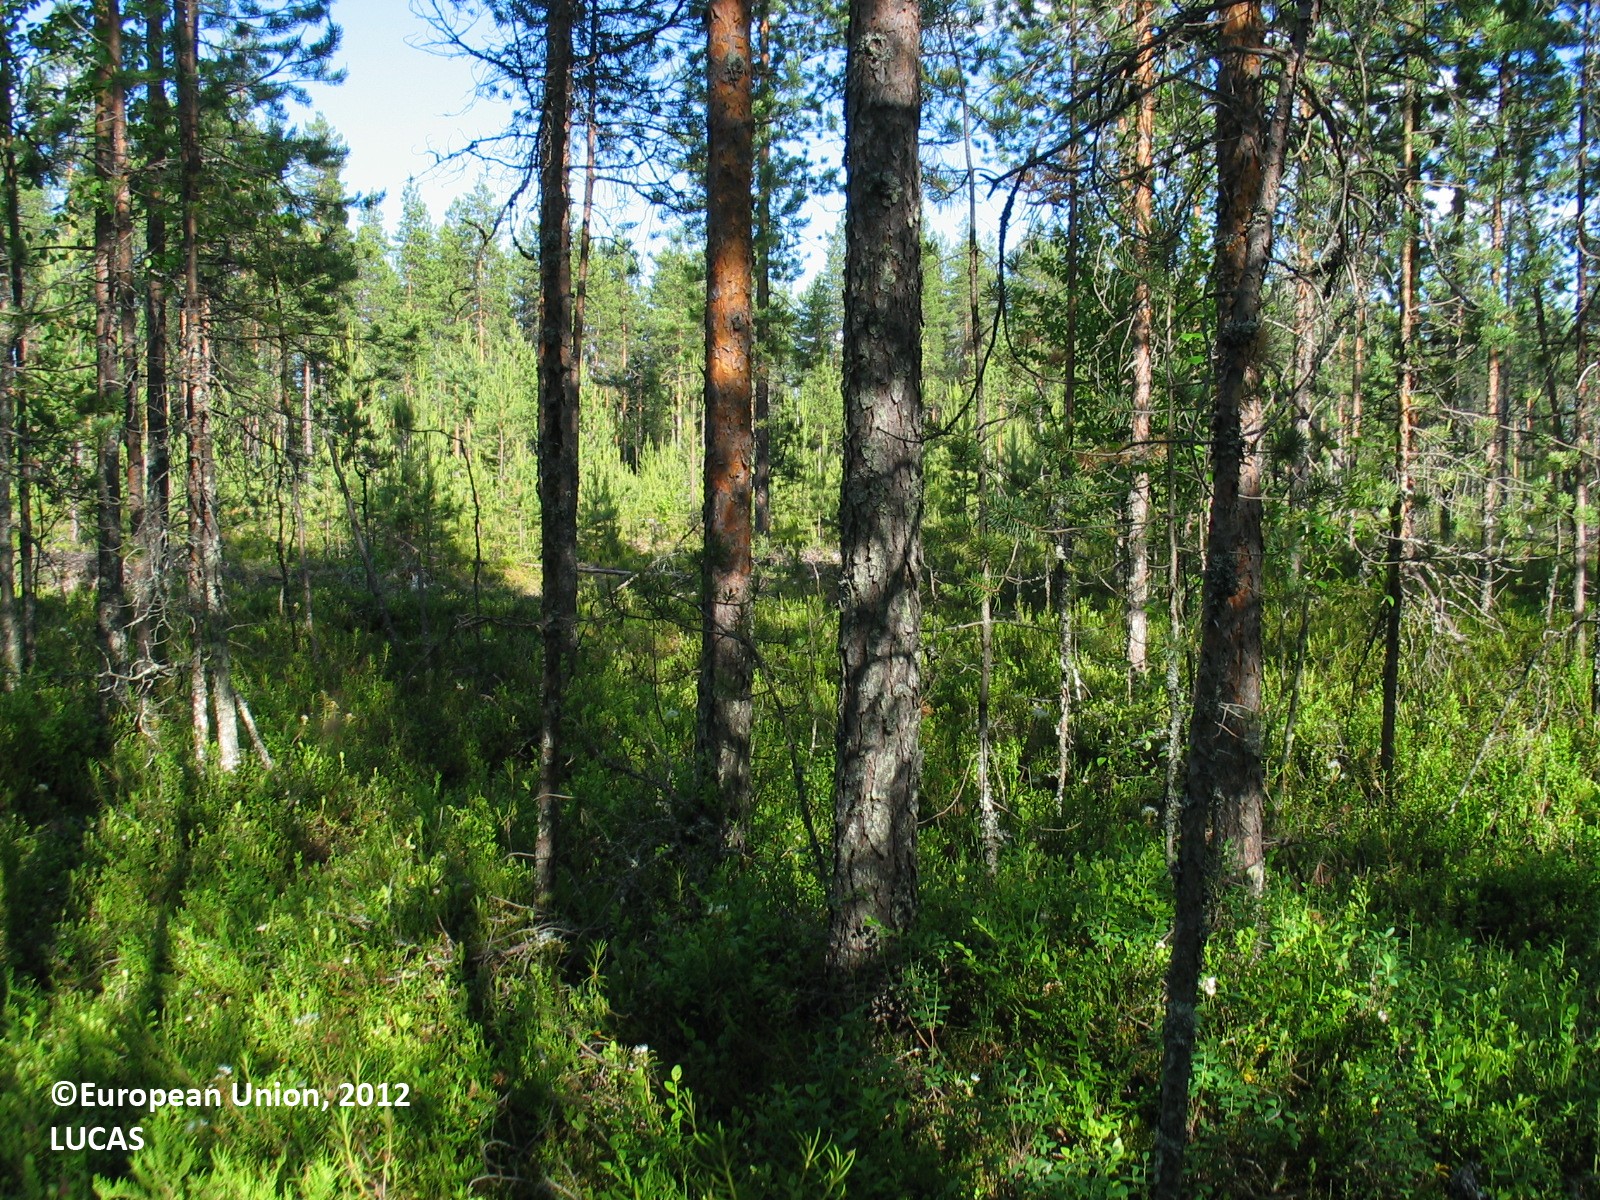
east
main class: Woodland
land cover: Pine dominated coniferous woodland
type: boreal forest
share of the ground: 50 - 75 %
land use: Forestry
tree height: > 5 m
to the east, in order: Pine dominated coniferous woodland; Tracks; Pine dominated coniferous woodland; Ditches and canals; Pine dominated coniferous woodland; Pine dominated mixed woodland; Other mixed woodland; Rivers and streams; Pine dominated coniferous woodland
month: July
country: FI
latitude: 64.6912
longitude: 26.7008
